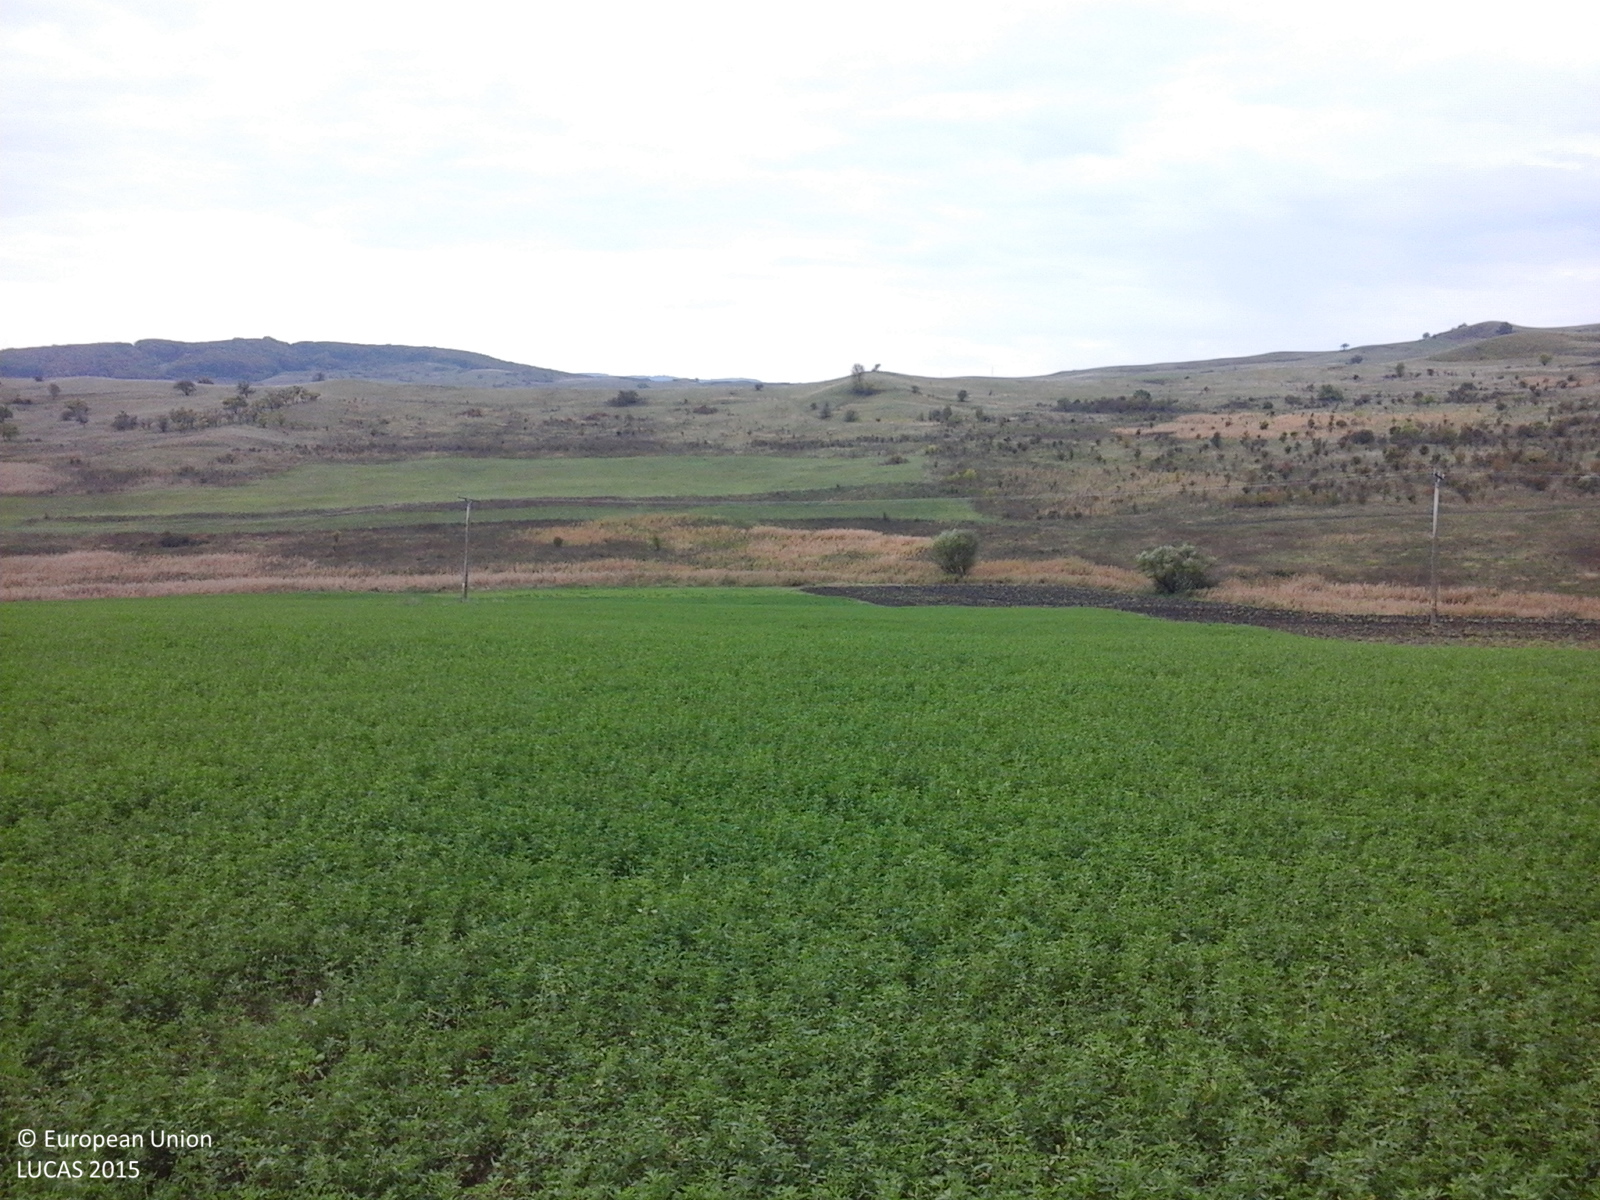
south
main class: Cropland
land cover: Lucerne
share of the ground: > 75 %
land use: Agriculture (excluding fallow land and kitchen gardens)
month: October
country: RO
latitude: 46.3544
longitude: 25.0821
